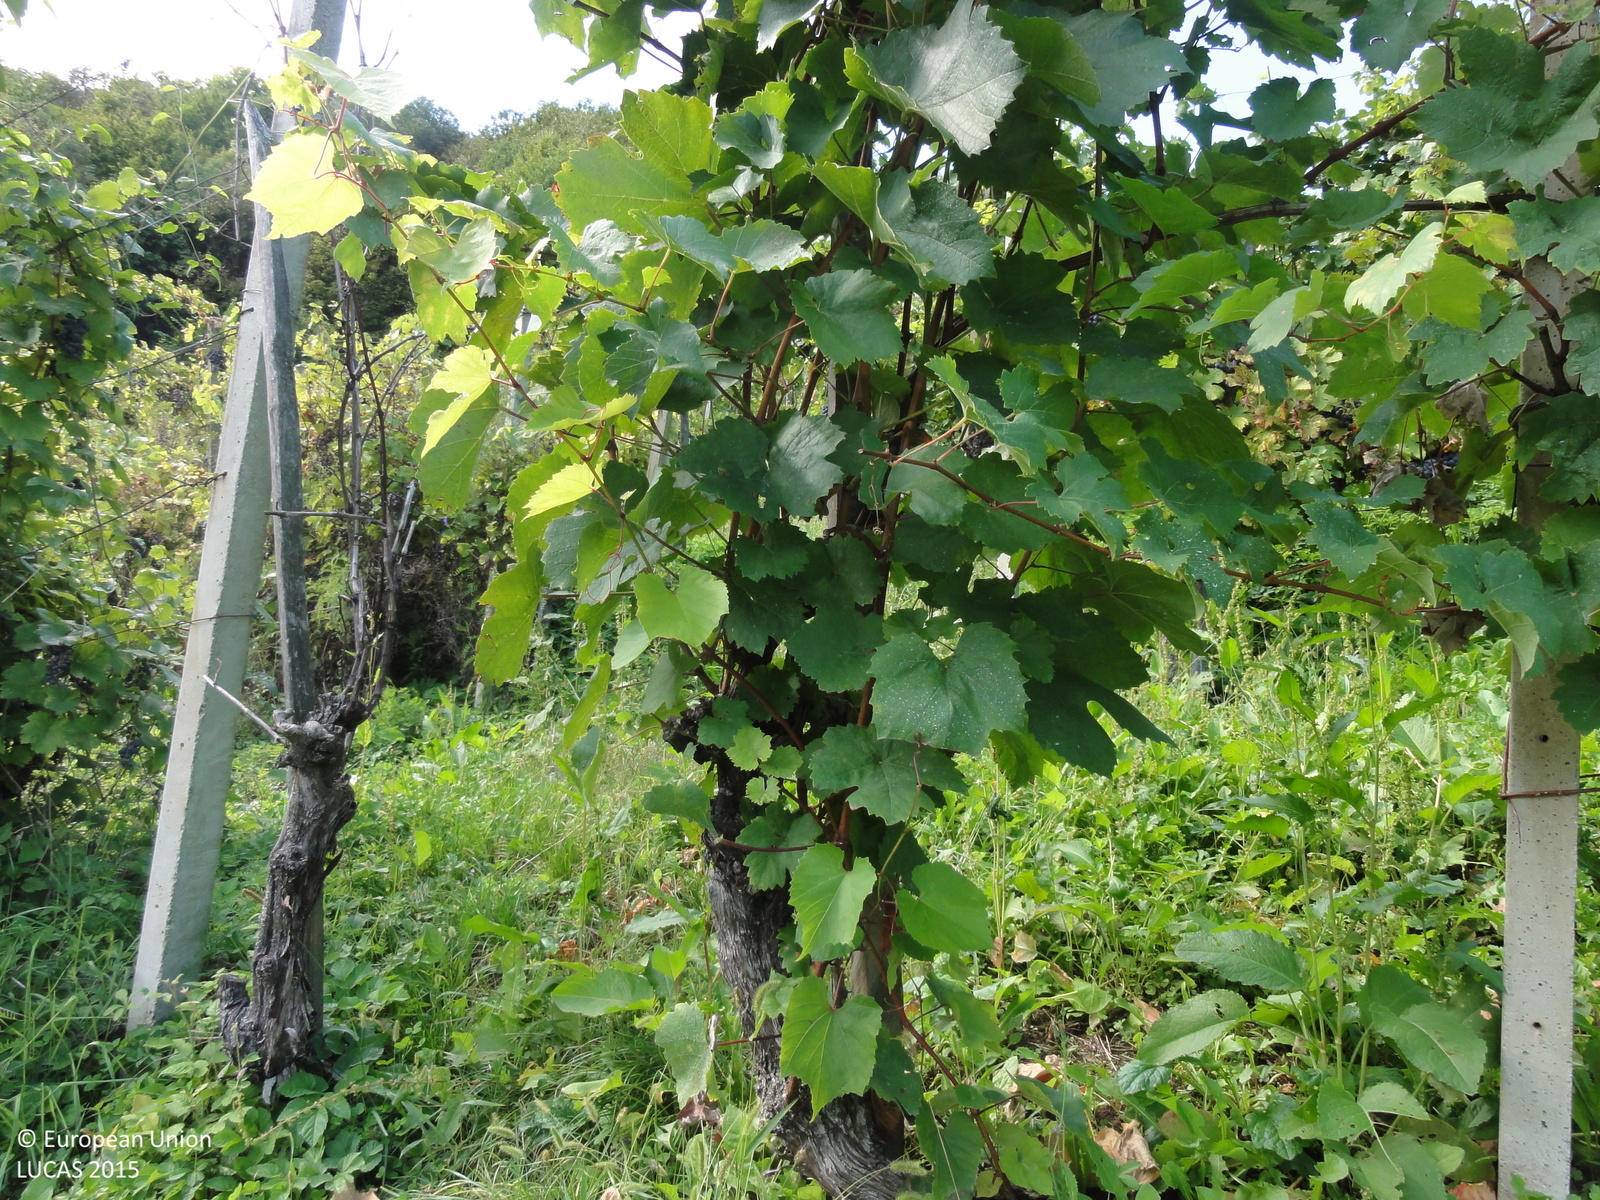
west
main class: Cropland
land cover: Vineyards
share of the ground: 50 - 75 %
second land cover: Grassland without tree/shrub cover
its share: > 75 %
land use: Agriculture (excluding fallow land and kitchen gardens)
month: September
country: SI
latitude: 45.8502
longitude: 15.4701
